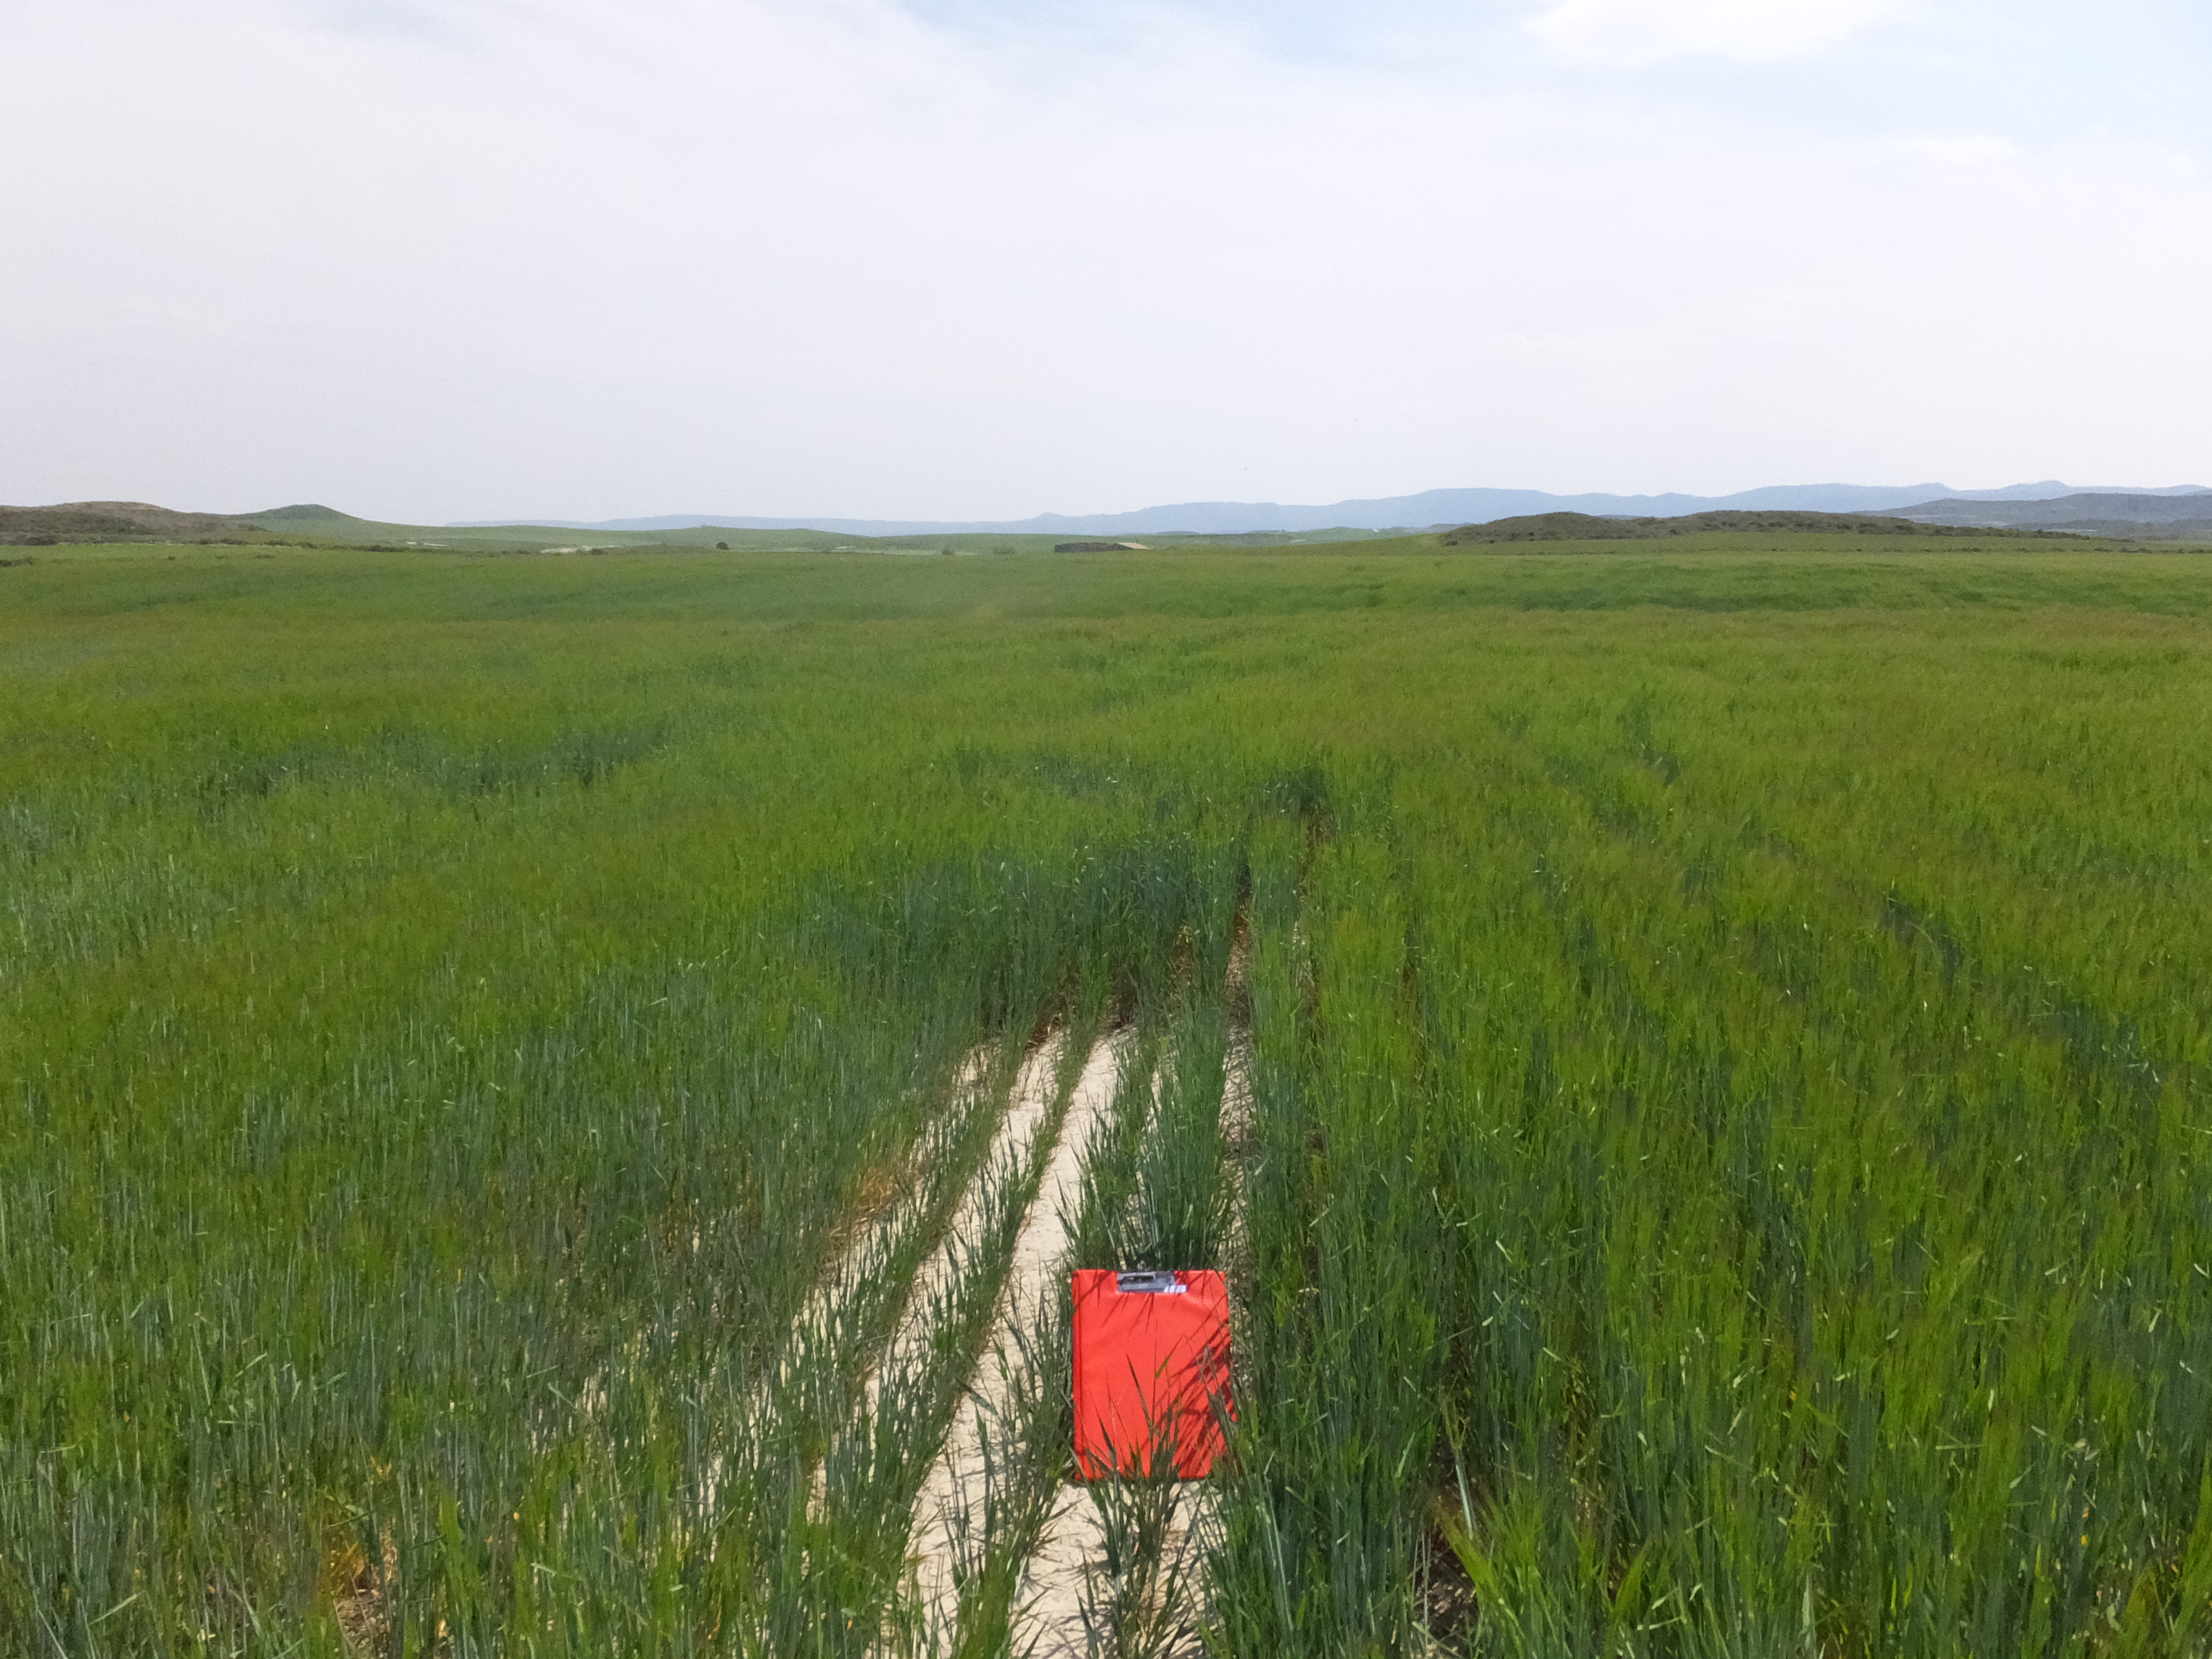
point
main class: Cropland
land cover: Barley
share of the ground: > 75 %
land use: Agriculture (excluding fallow land and kitchen gardens)
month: April
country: ES
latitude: 41.7713
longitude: -0.4011
